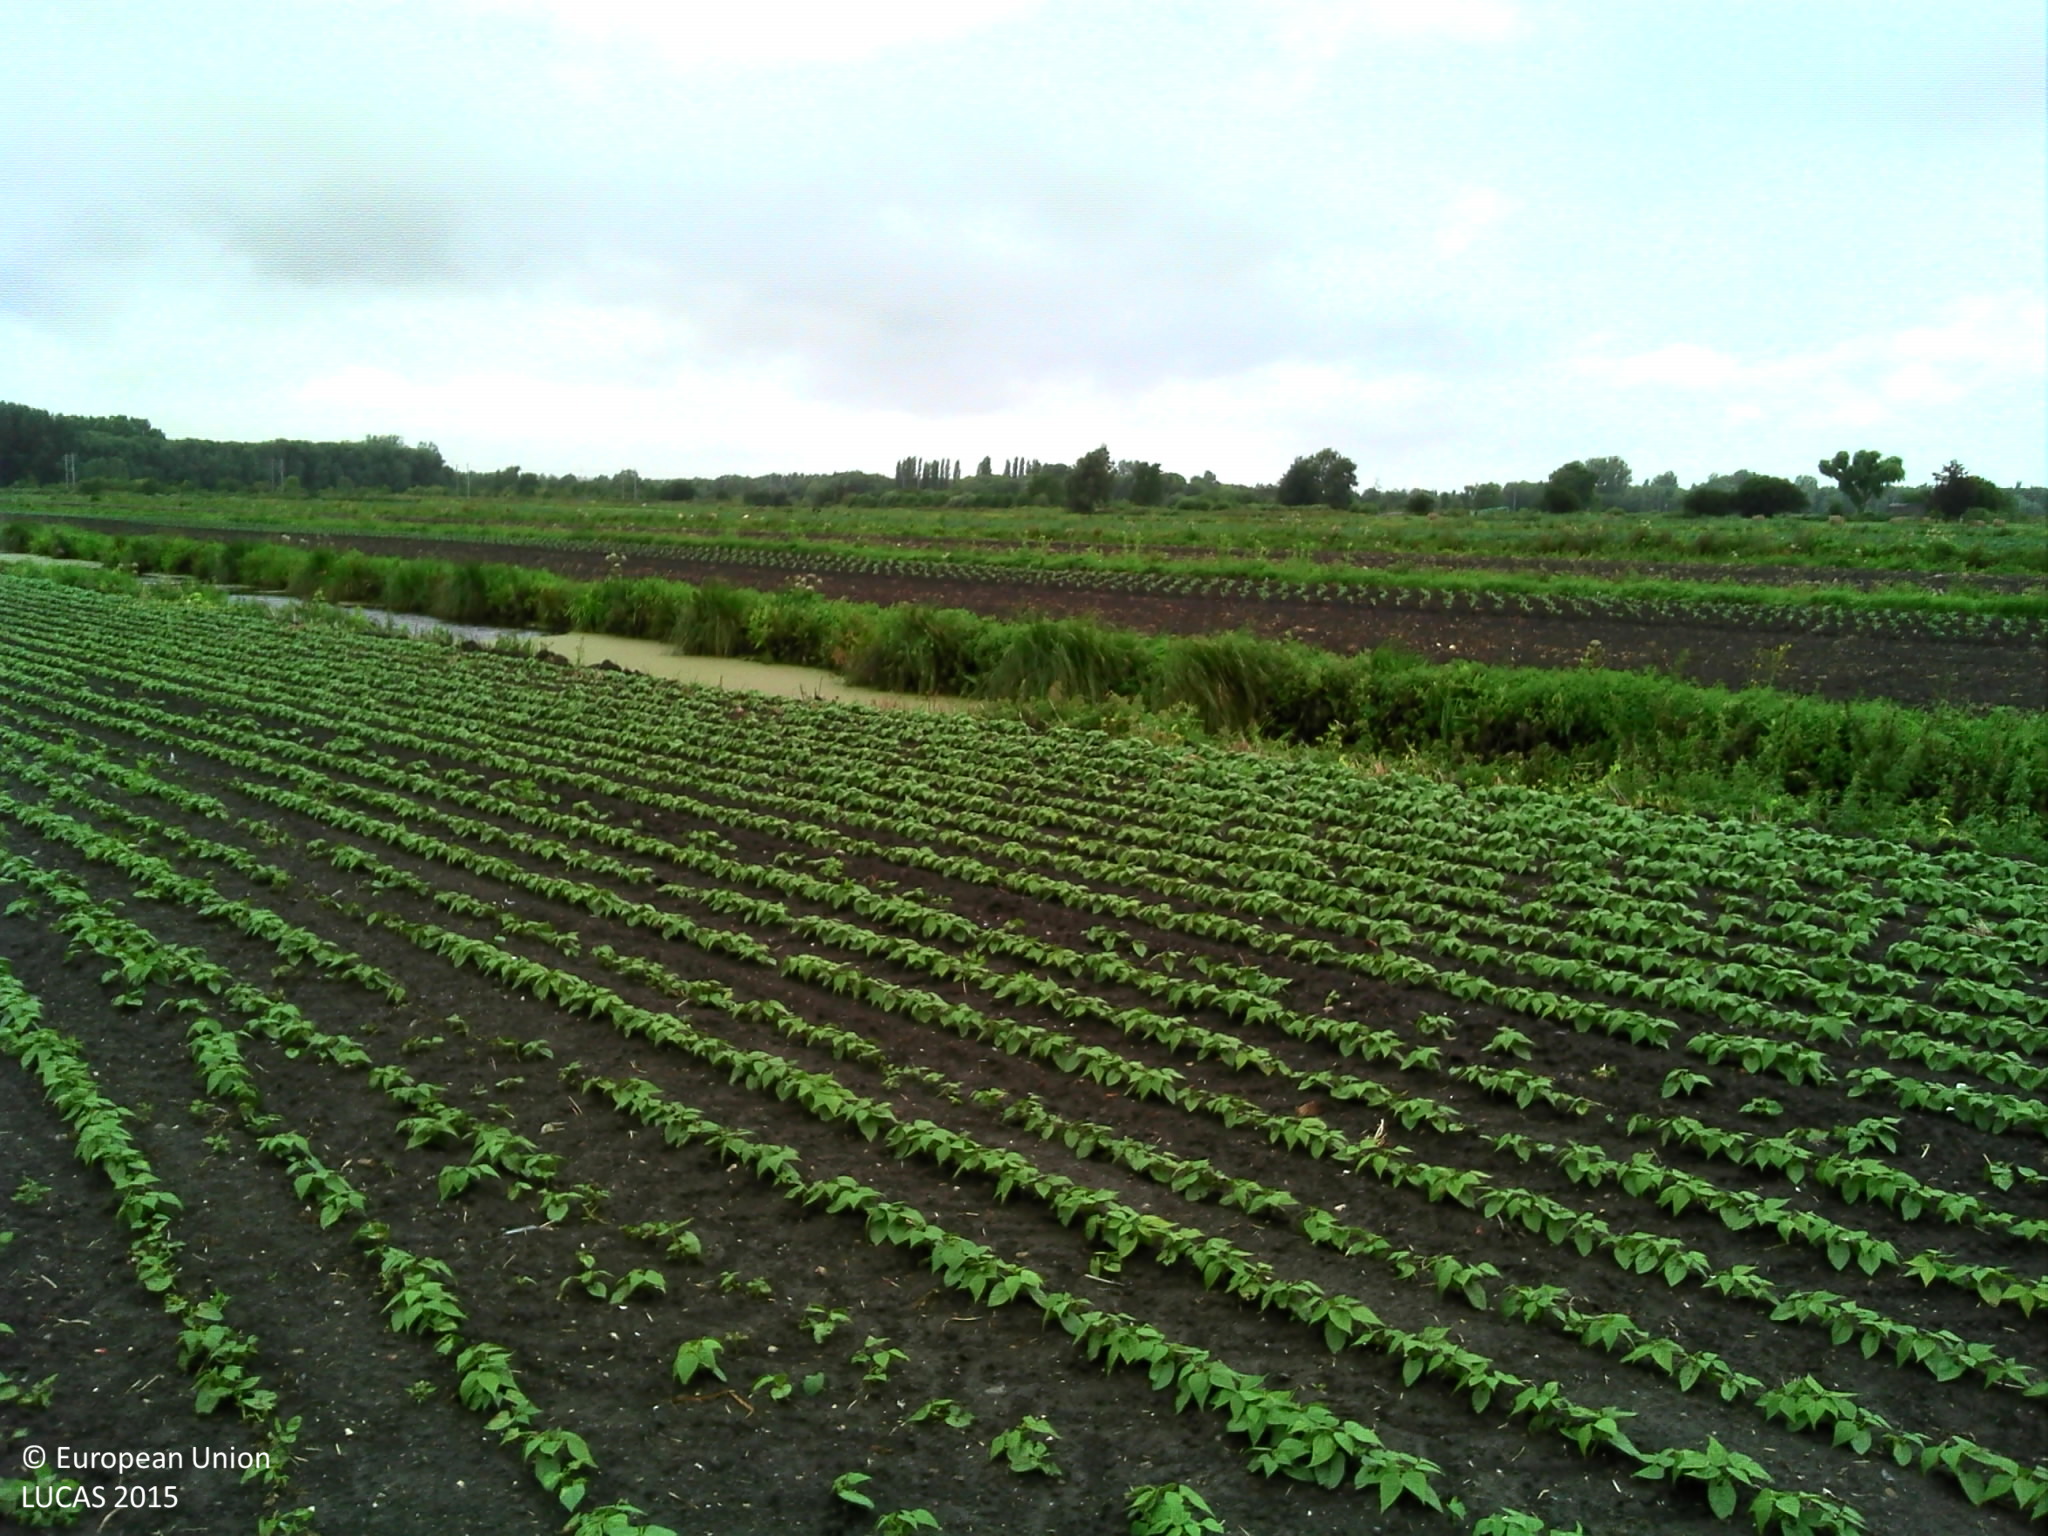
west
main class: Cropland
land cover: Other fresh vegetables
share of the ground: 25 - 50 %
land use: Agriculture (excluding fallow land and kitchen gardens)
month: July
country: FR
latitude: 50.7698
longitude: 2.2580
